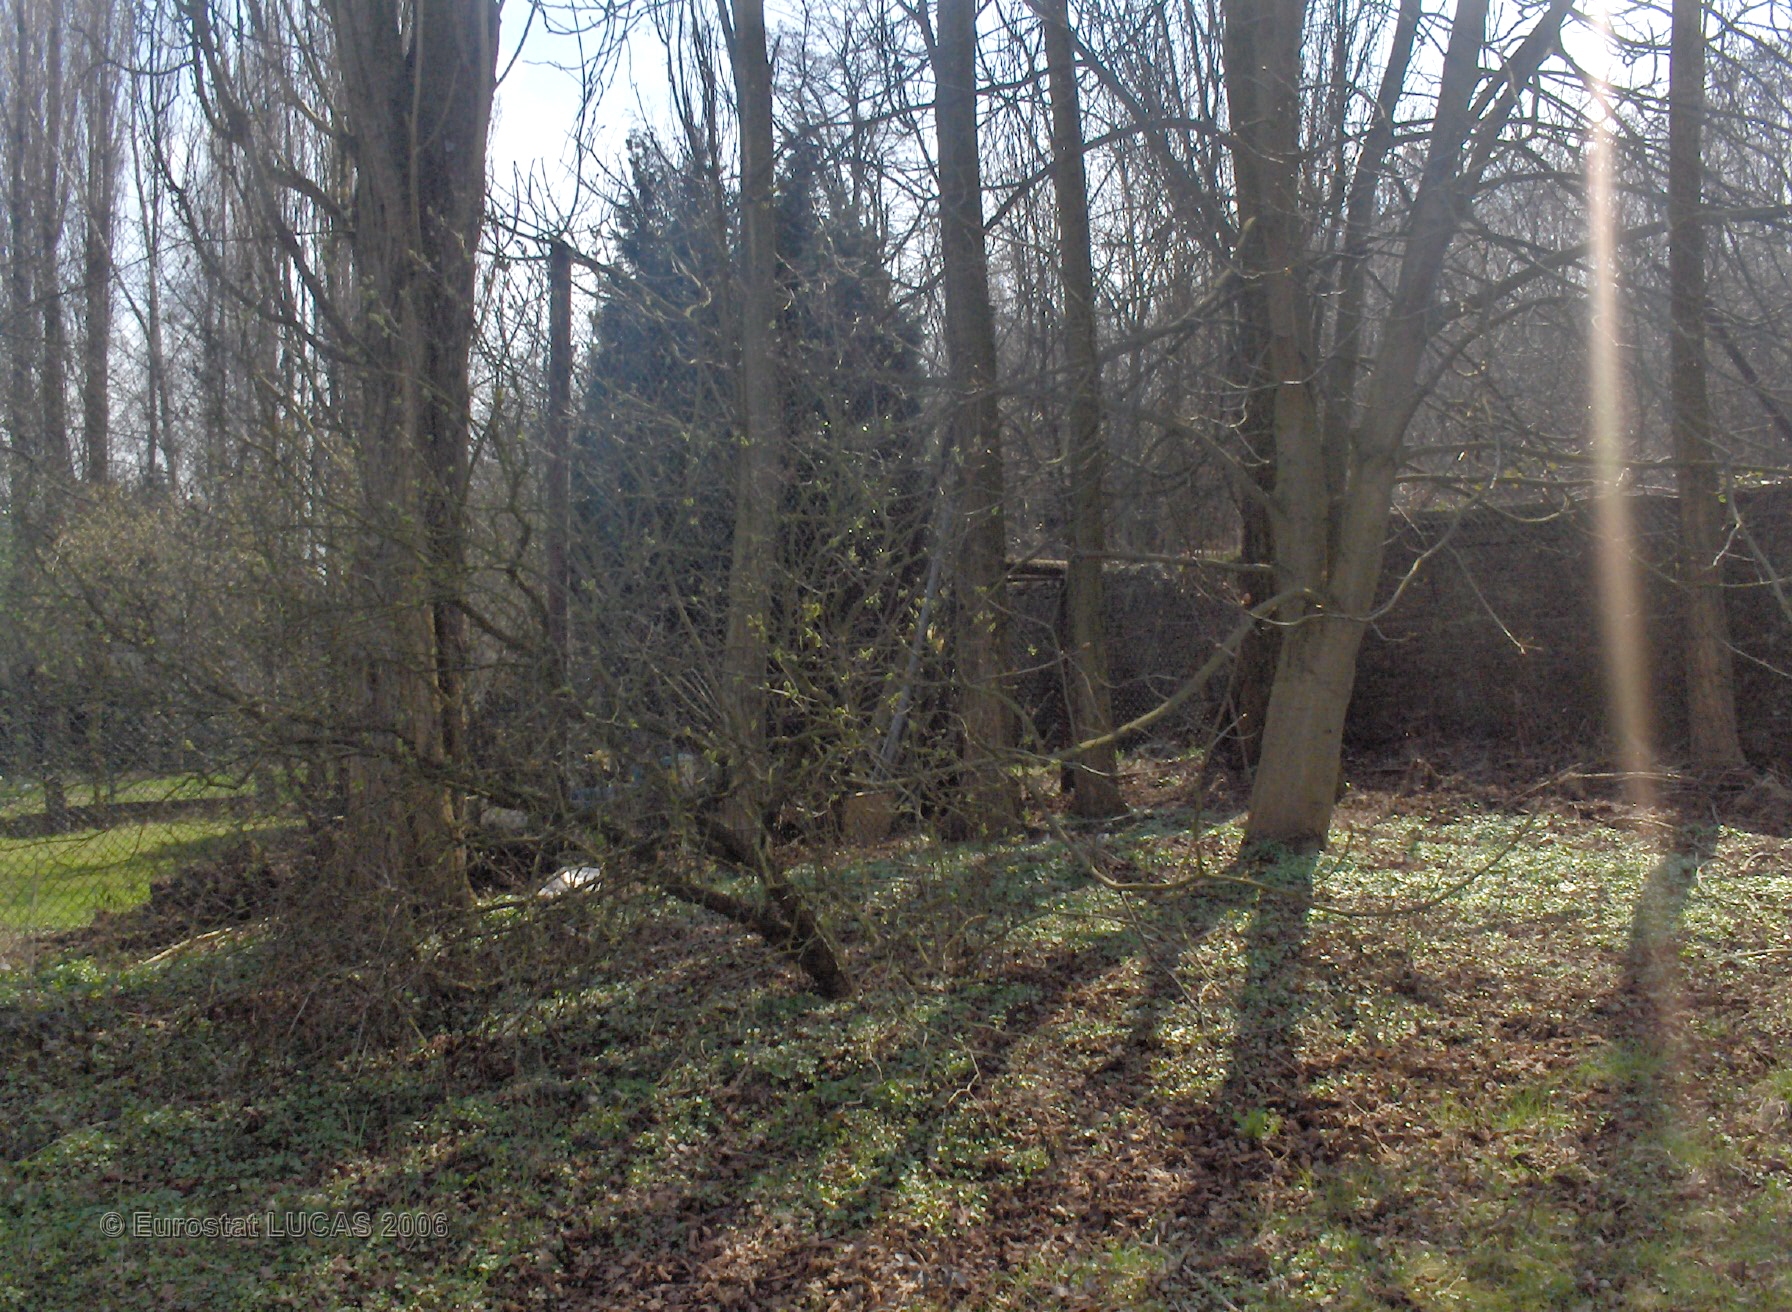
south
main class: Grassland
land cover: Grassland with sparse tree/shrub cover
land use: Agriculture (excluding fallow land and kitchen gardens)
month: April
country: BE
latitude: 50.4144
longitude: 4.5498
